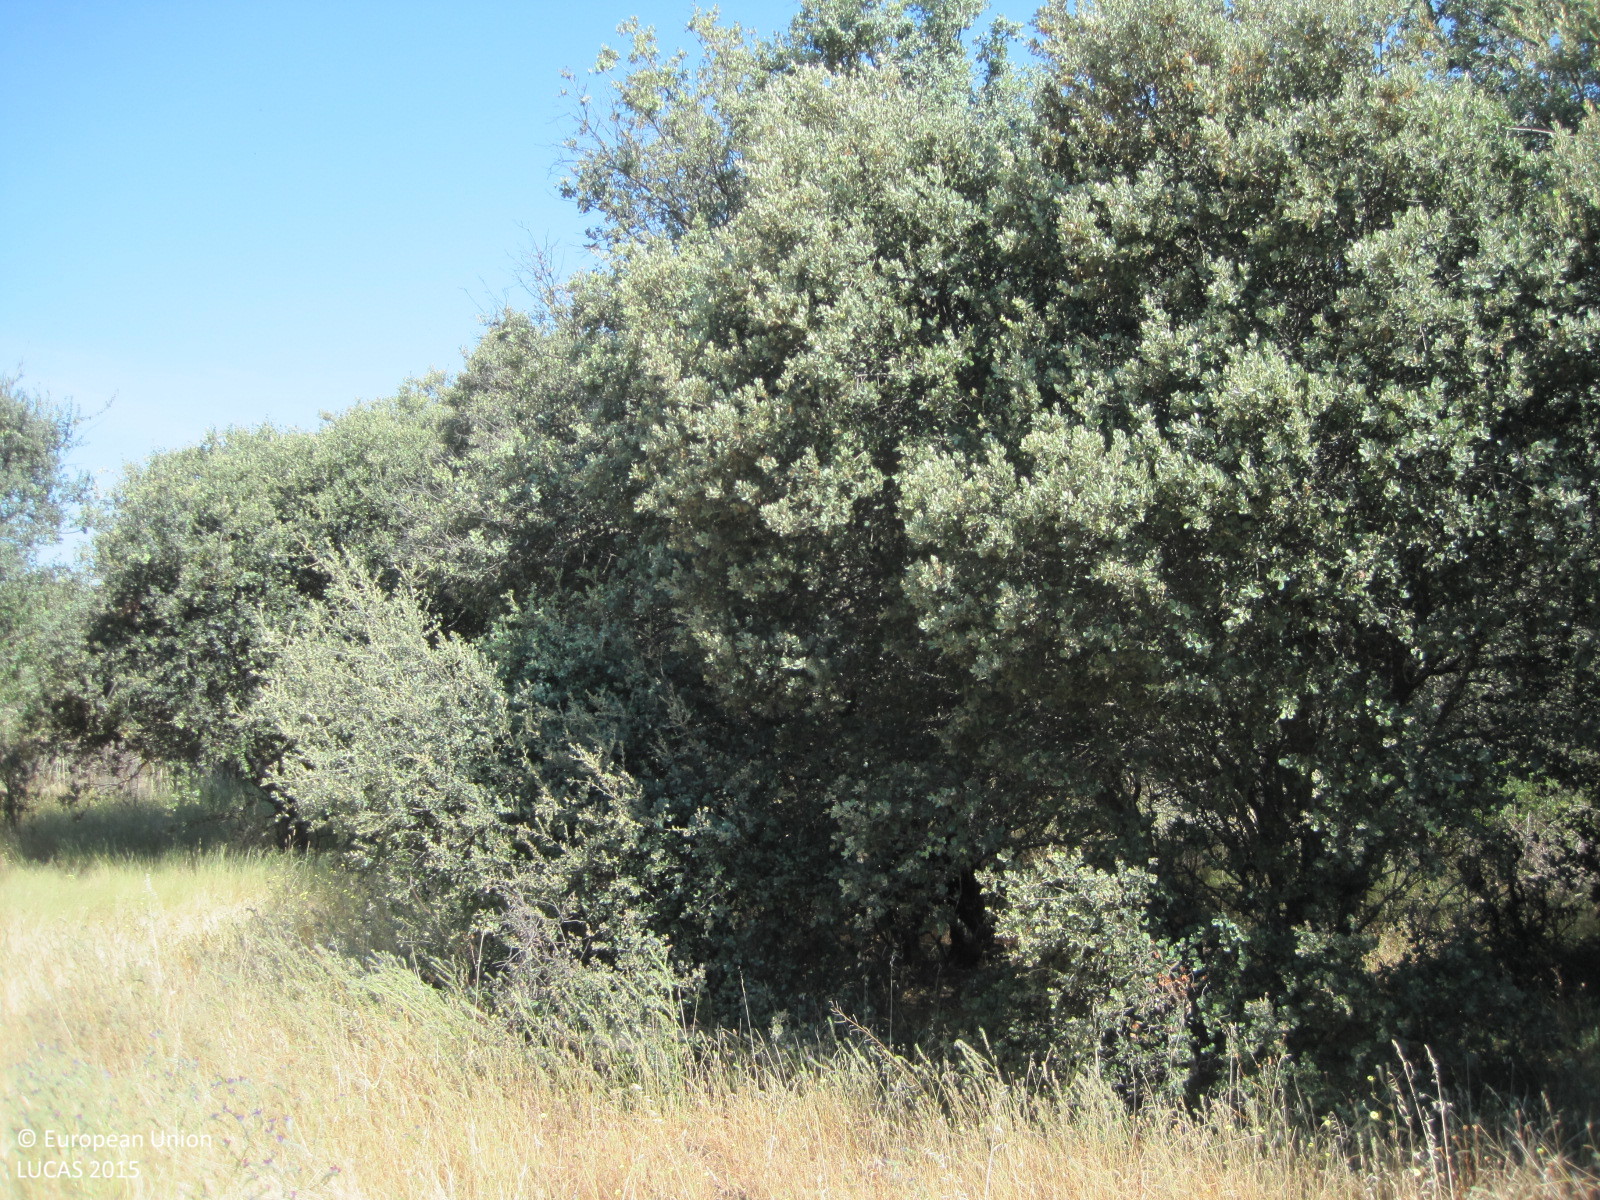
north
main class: Woodland
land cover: Broadleaved woodland
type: broadleaved evergreen forest
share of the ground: 50 - 75 %
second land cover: Grassland without tree/shrub cover
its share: 50 - 75 %
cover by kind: broadleaved forest trees 90 %, herbaceous plants 10 %
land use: Forestry
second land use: Agriculture (excluding fallow land and kitchen gardens)
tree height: < 5 m
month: June
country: ES
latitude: 40.0901
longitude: -4.8159
